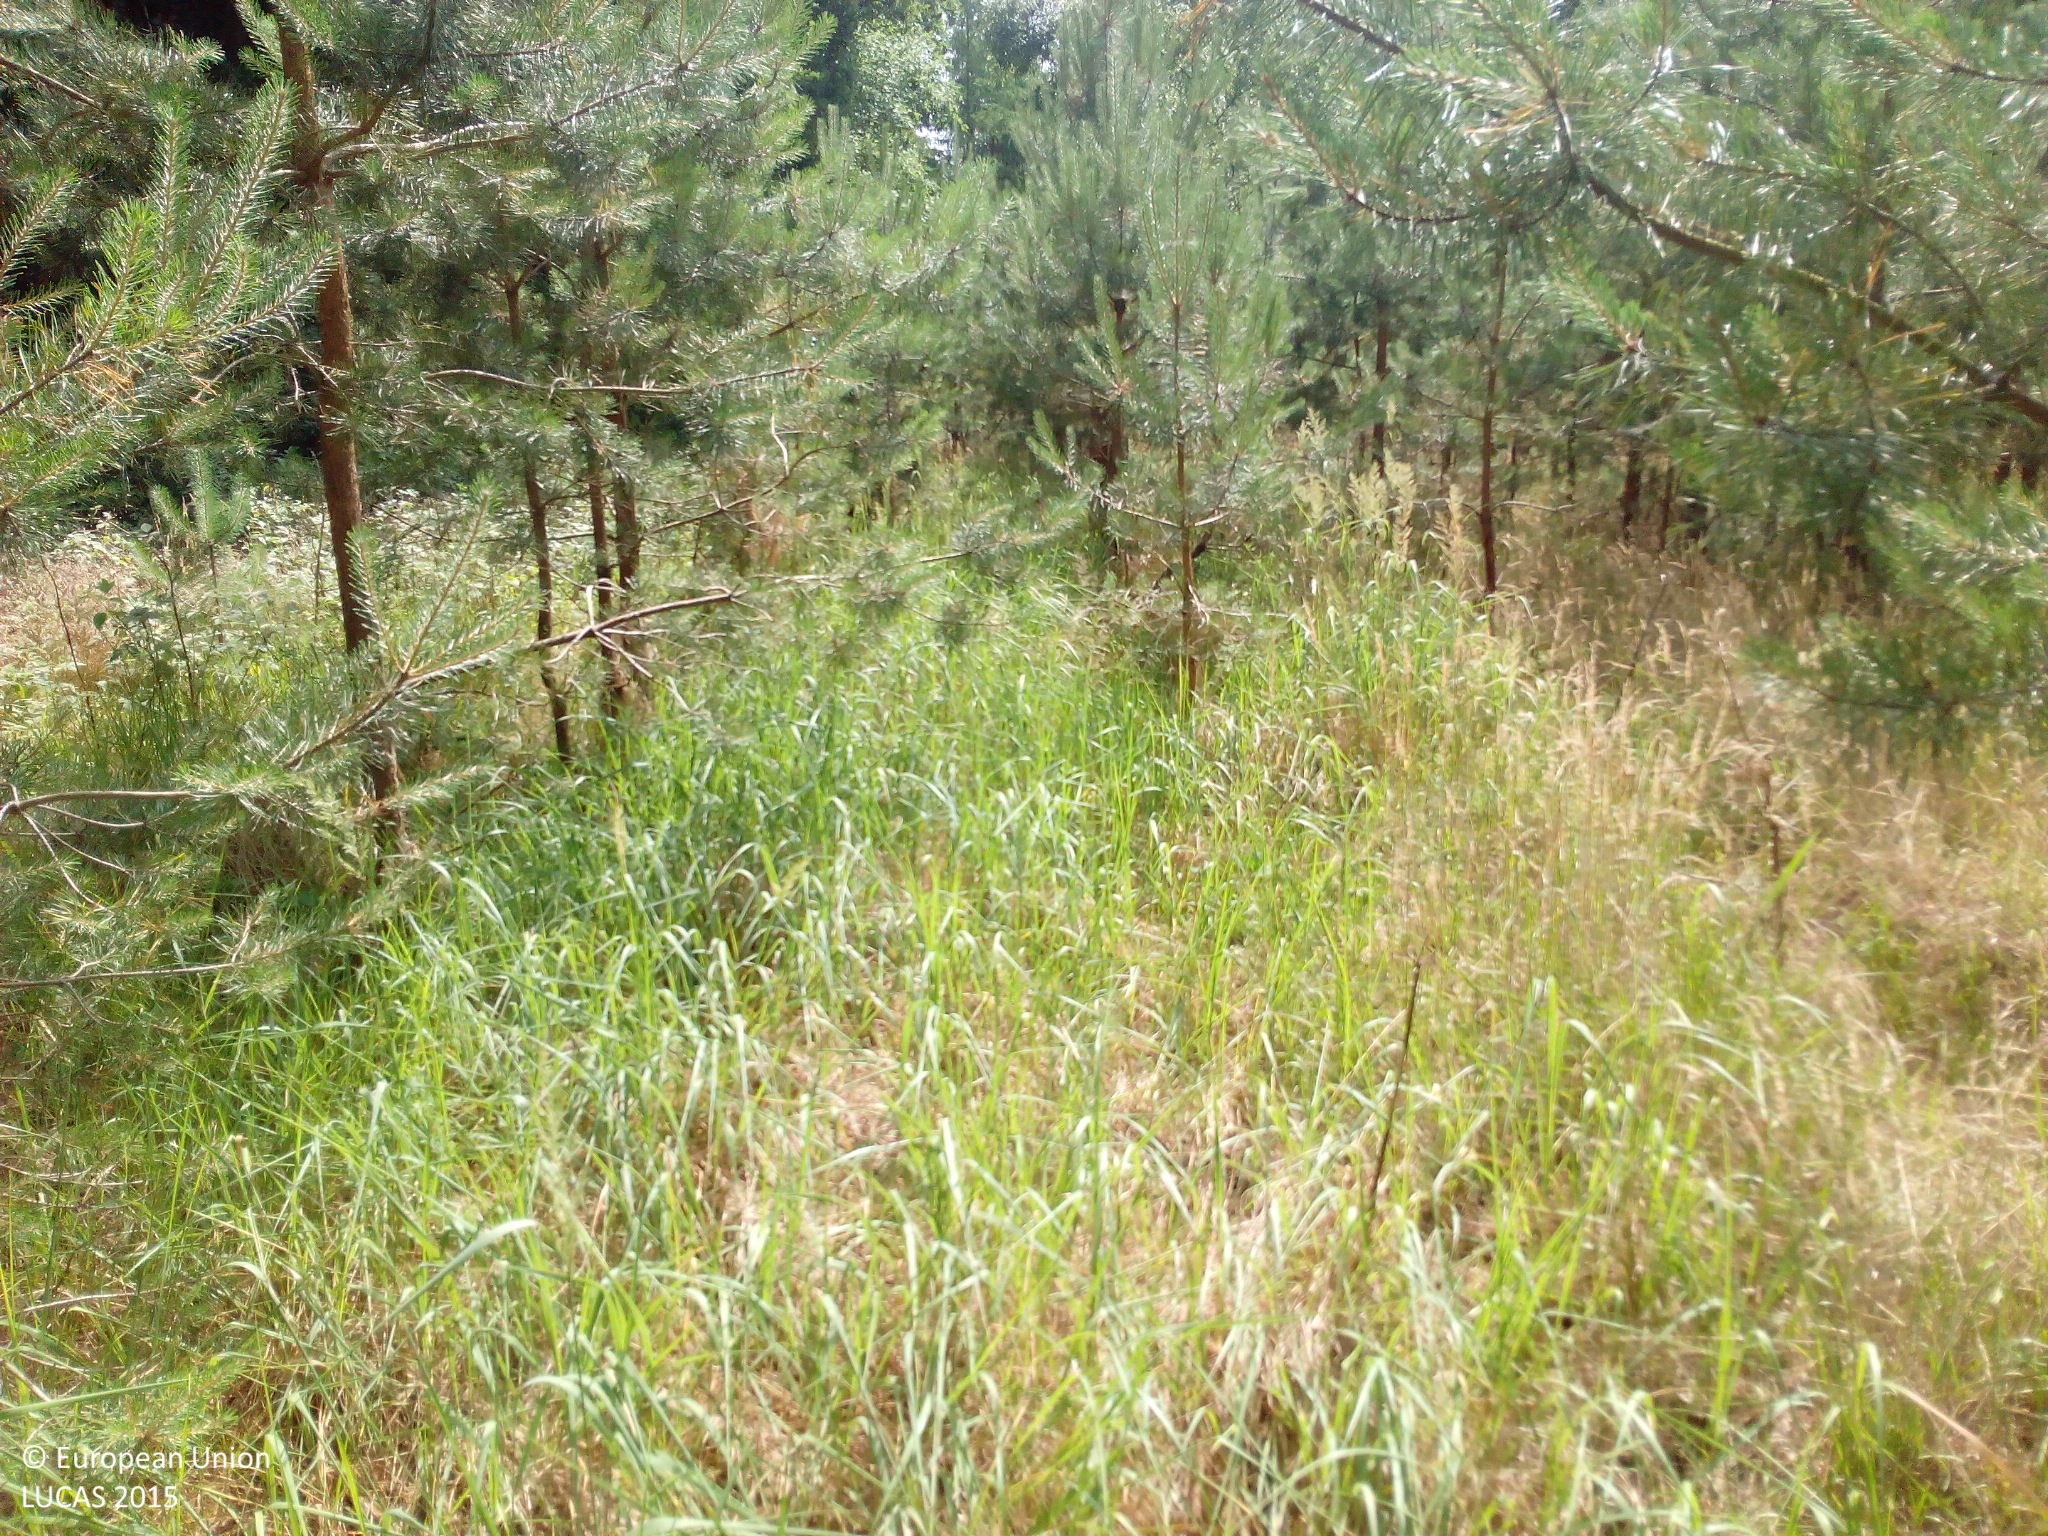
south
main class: Woodland
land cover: Pine dominated coniferous woodland
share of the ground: 50 - 75 %
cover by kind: coniferous forest trees 50 %, herbaceous plants 50 %
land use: Forestry
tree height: < 5 m
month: July
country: DE
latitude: 52.8760
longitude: 12.3322
